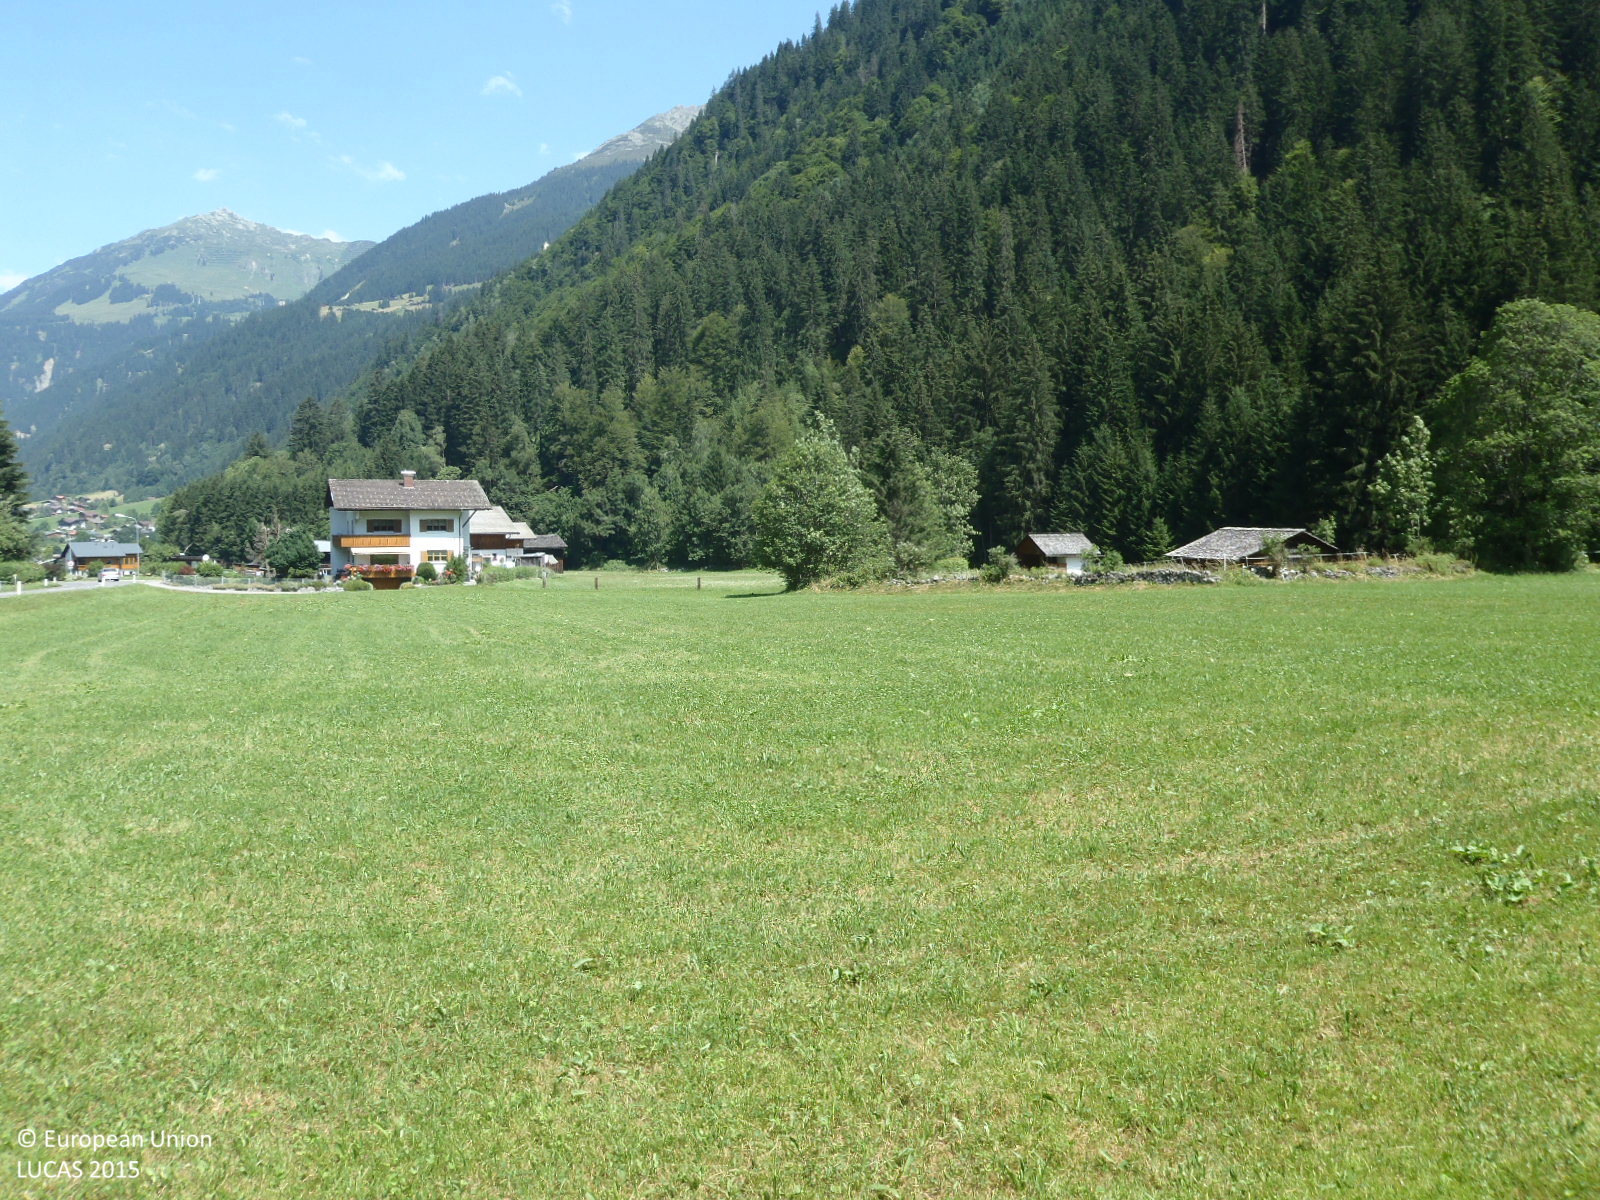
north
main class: Grassland
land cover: Grassland without tree/shrub cover
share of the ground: > 75 %
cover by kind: herbaceous plants 100 %
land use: Residential
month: July
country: AT
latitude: 46.9995
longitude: 10.0131
